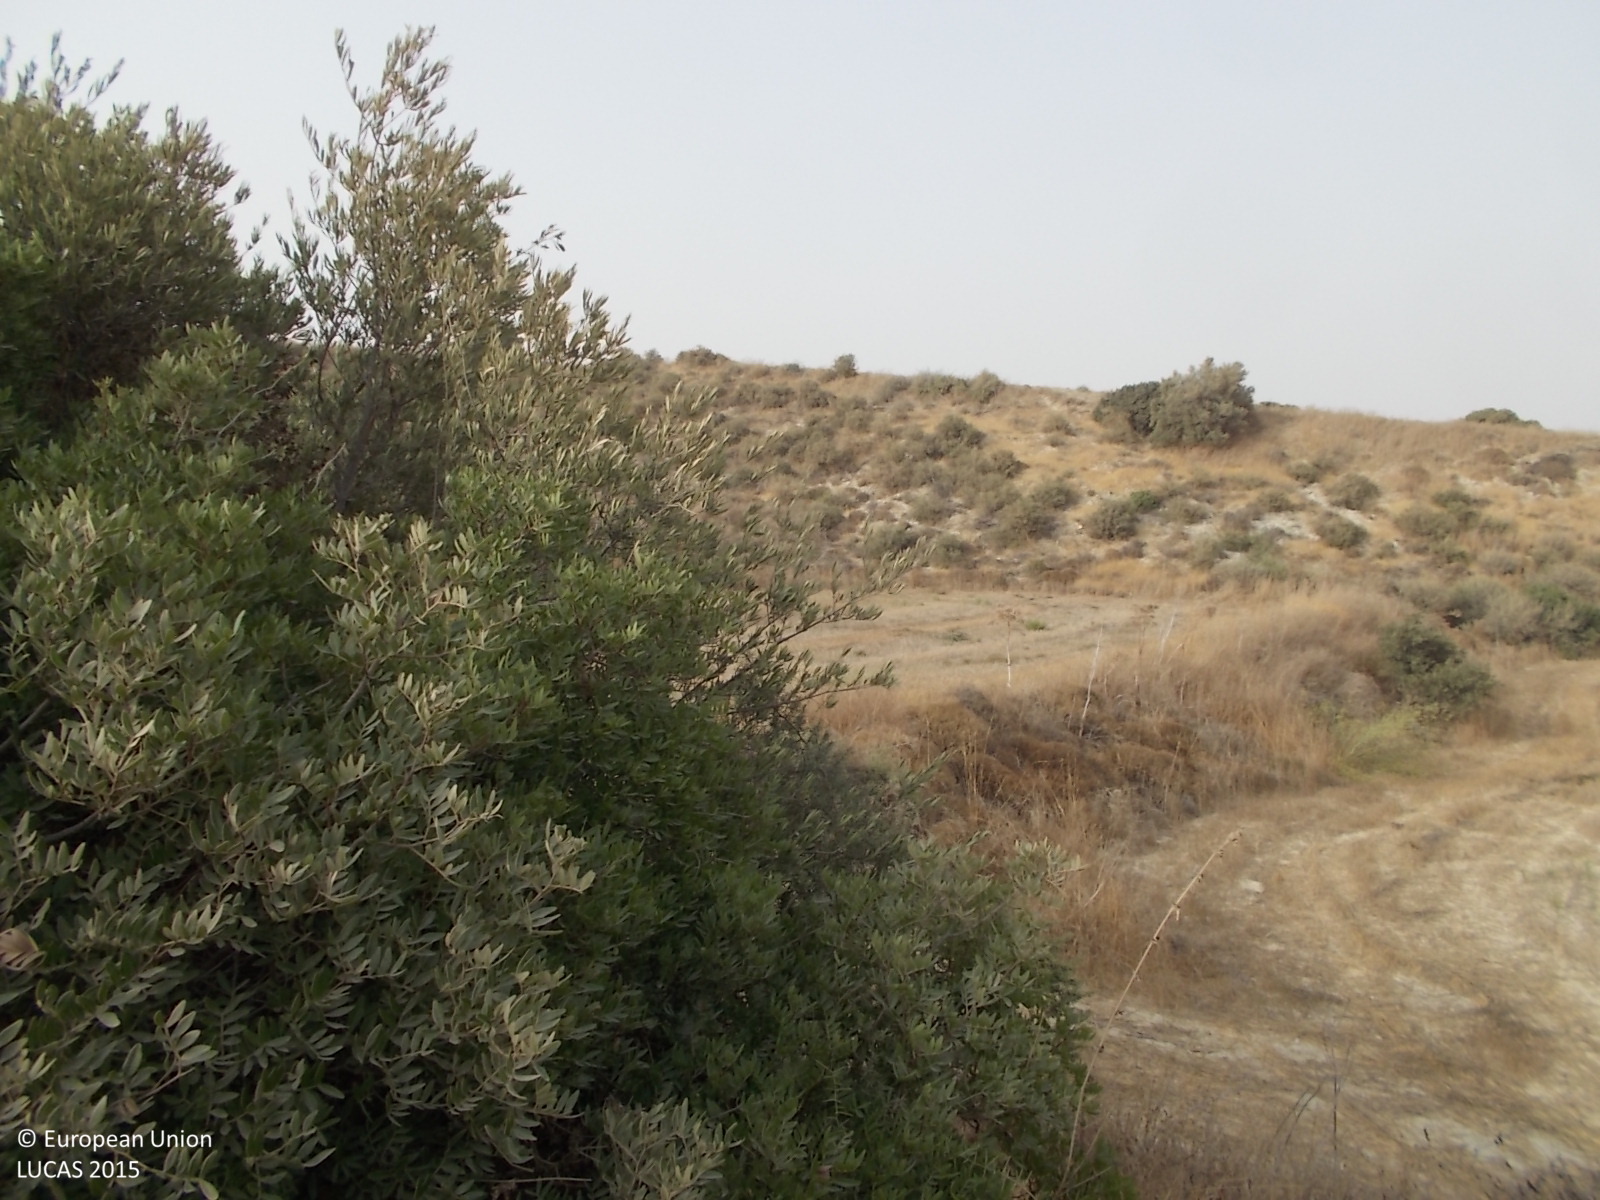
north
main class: Woodland
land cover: Broadleaved woodland
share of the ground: 25 - 50 %
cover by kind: herbaceous plants 60 %, broadleaved forest trees 30 %, unconsolidated bare surface 10 %
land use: Semi-natural and natural areas not in use
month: April
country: CY
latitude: 34.8006
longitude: 33.4103
